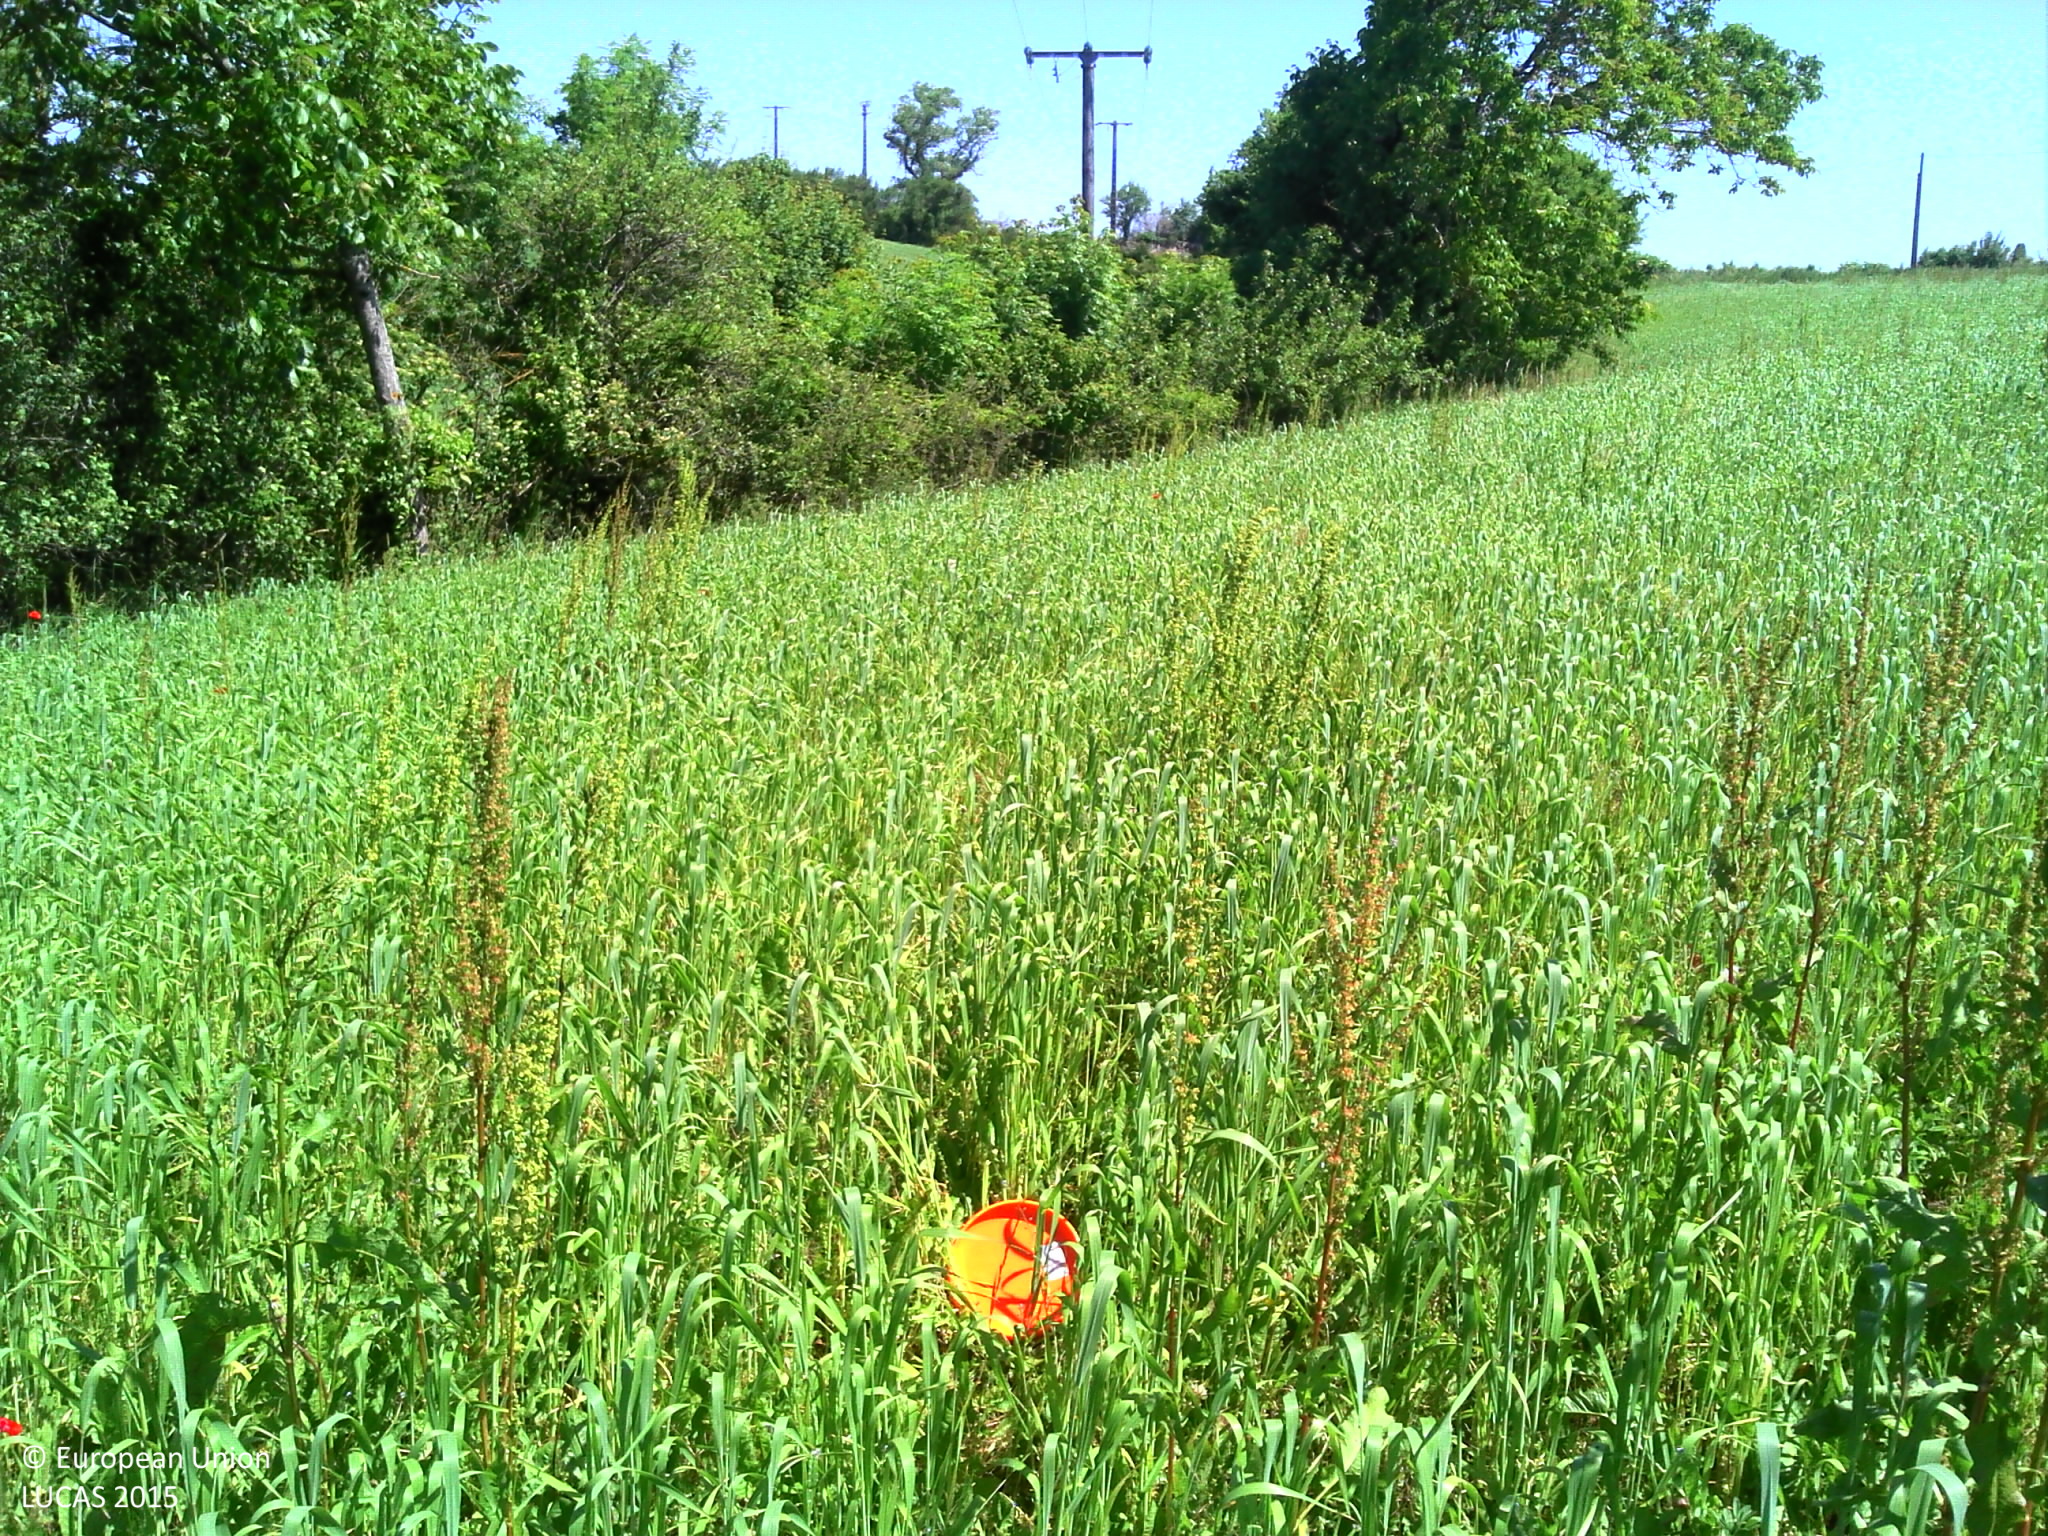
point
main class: Cropland
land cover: Barley
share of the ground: > 75 %
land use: Agriculture (excluding fallow land and kitchen gardens)
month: May
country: FR
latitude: 44.5394
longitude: 1.8822
